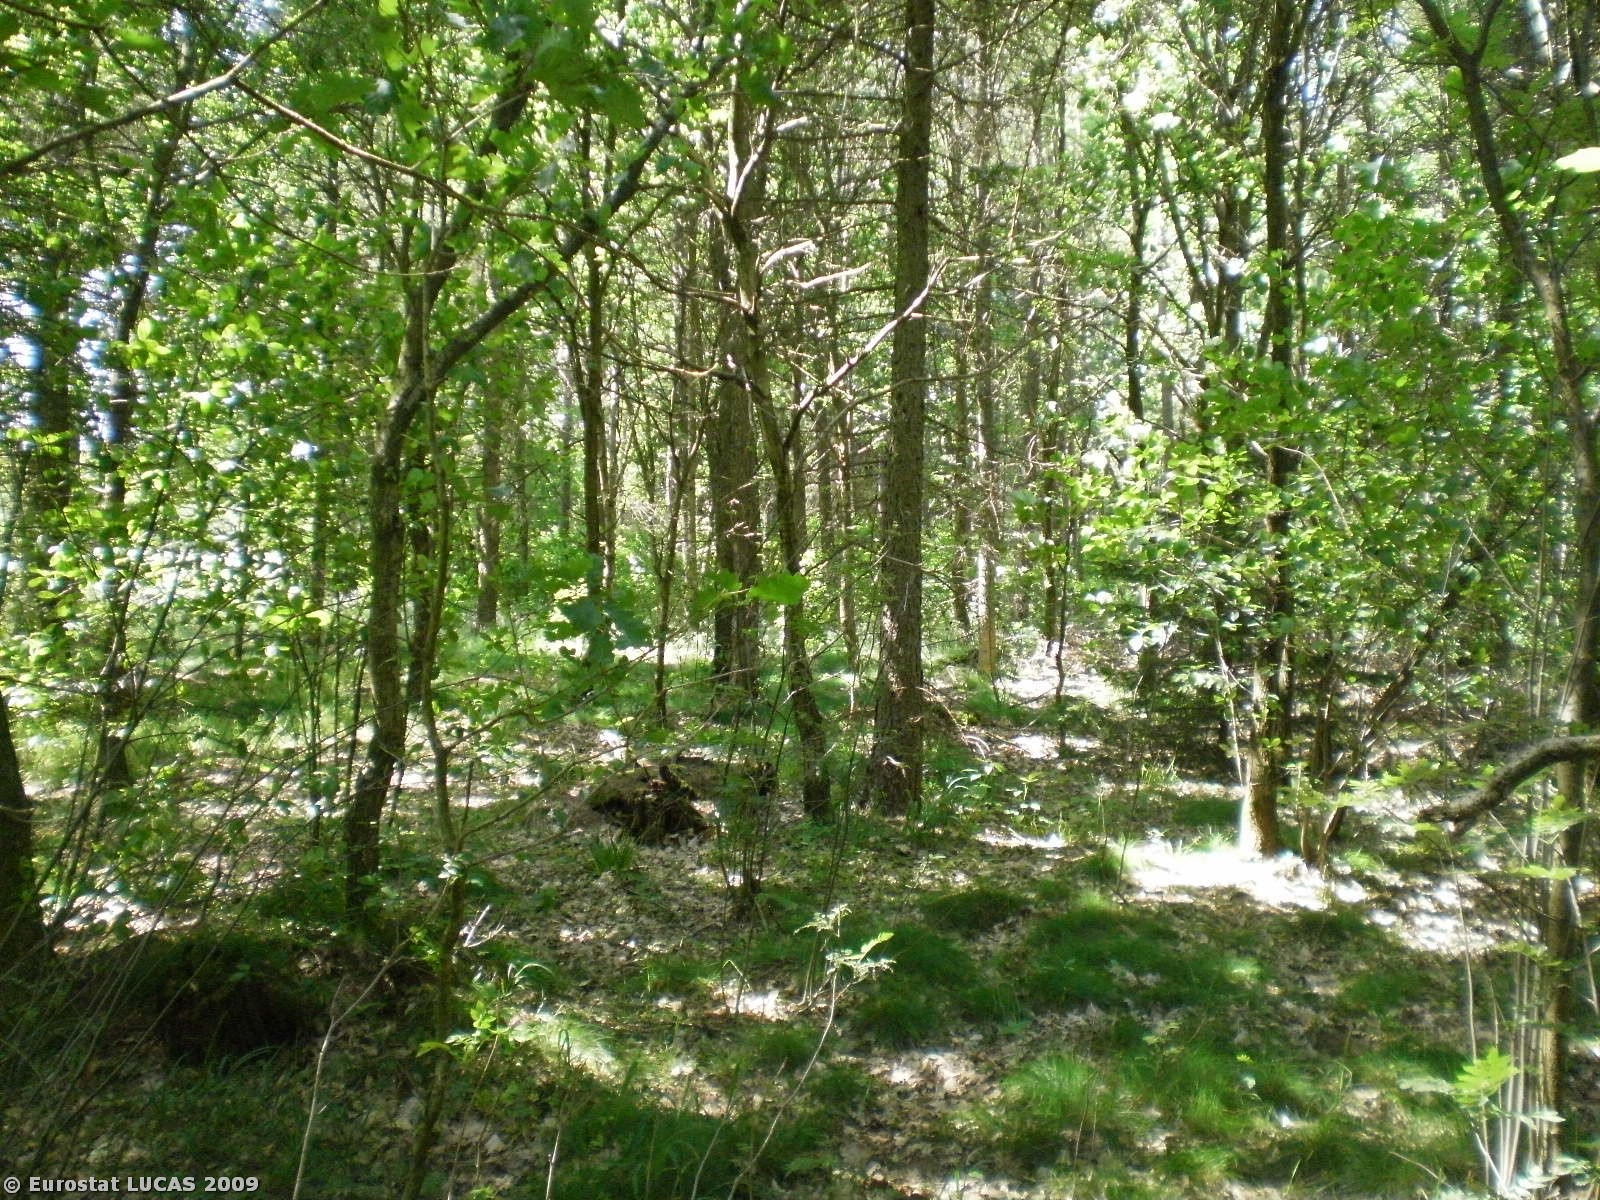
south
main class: Woodland
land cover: Mixed woodland
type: hemiboreal forest and nemoral coniferous forest and mixed broadleaved-coniferous forest
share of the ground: > 75 %
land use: Forestry
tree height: > 5 m
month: June
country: PL
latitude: 54.4628
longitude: 17.3066
